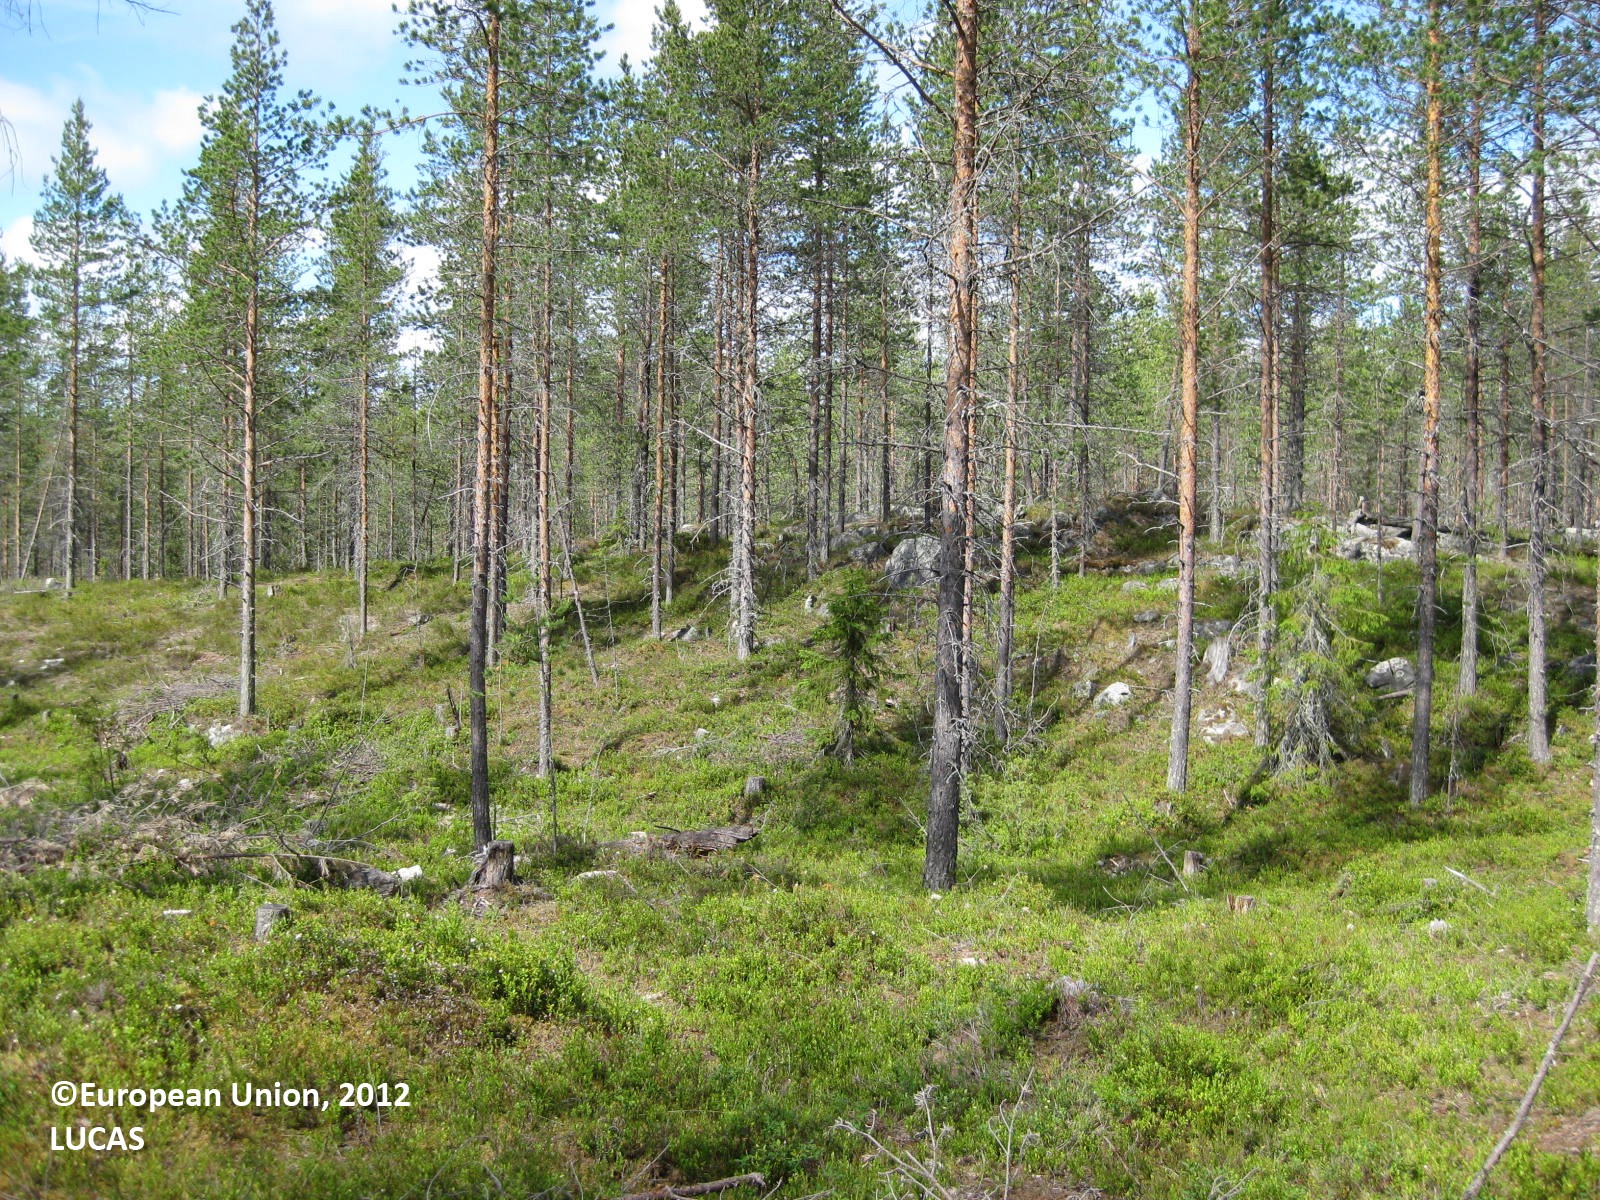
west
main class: Woodland
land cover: Pine dominated coniferous woodland
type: boreal forest
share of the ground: 25 - 50 %
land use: Forestry
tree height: > 5 m
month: July
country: FI
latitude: 65.4557
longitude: 29.5087
